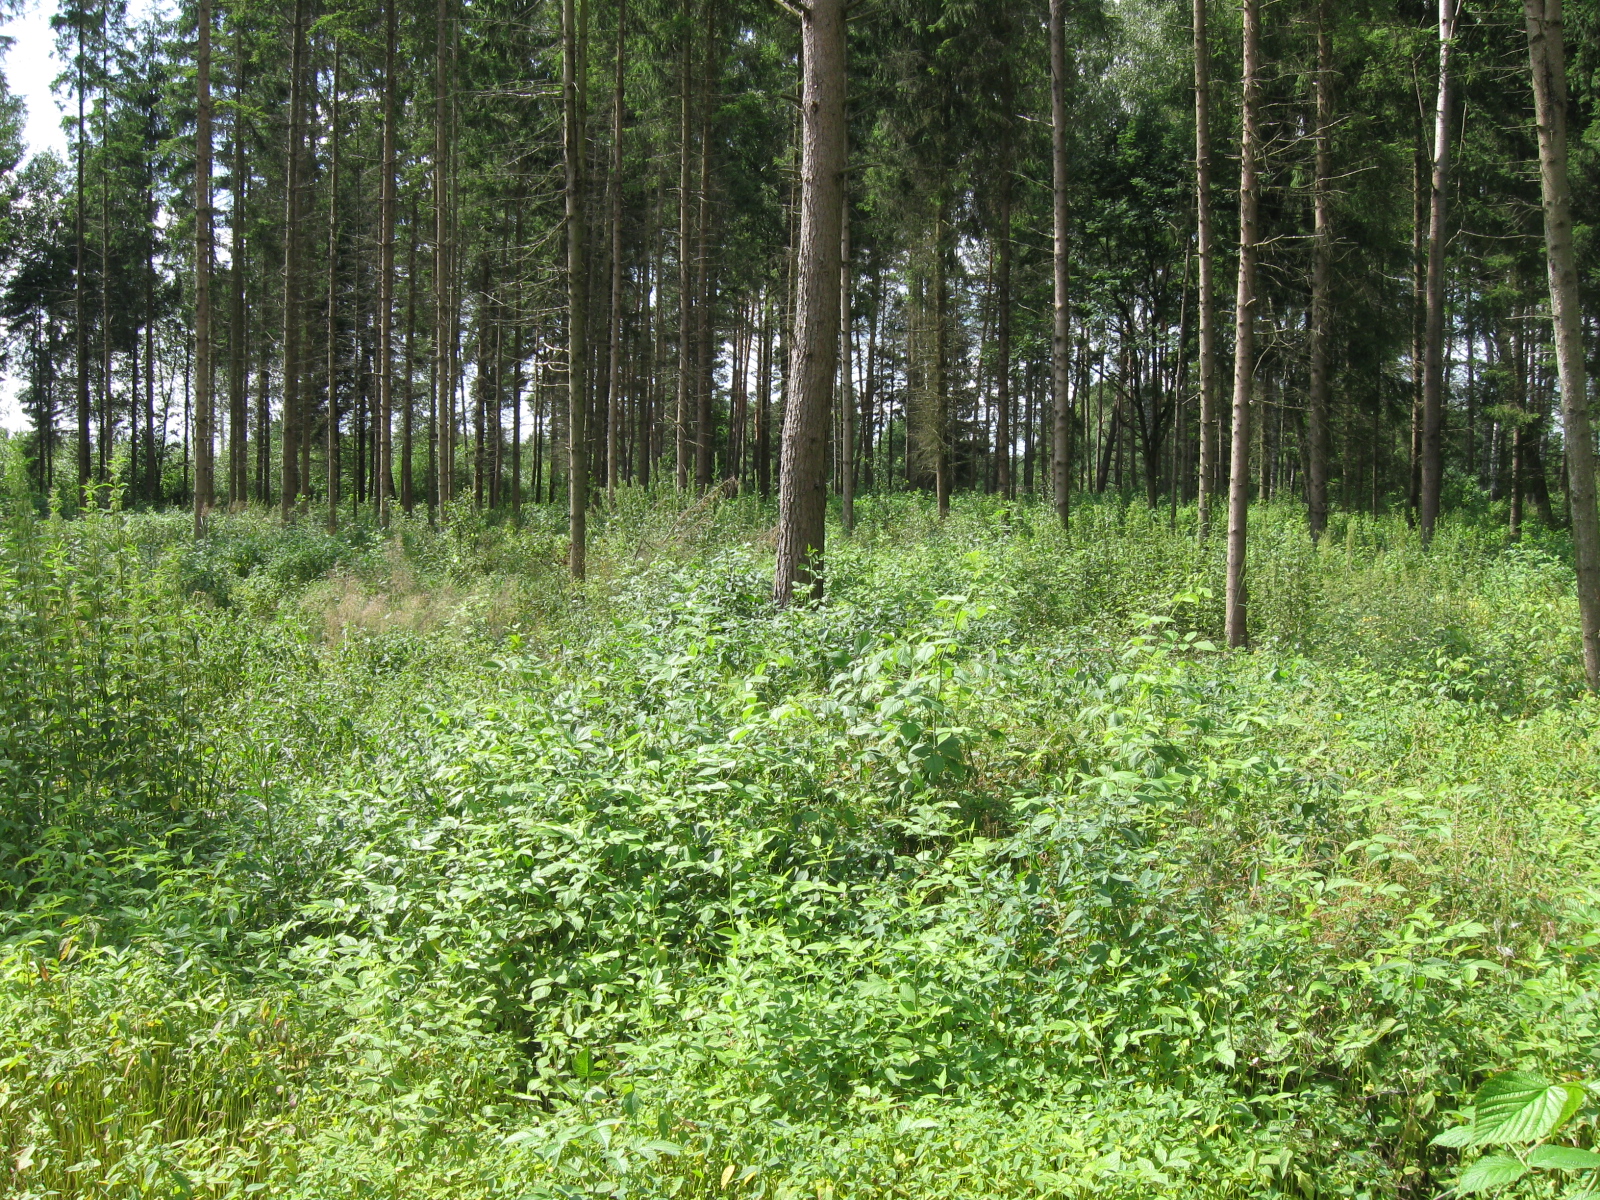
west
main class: Shrubland
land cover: Shrubland with sparse tree cover
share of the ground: 50 - 75 %
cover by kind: herbaceous plants 50 %, shrubs 45 %, coniferous forest trees 5 %
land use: Forestry
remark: Clear cut
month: July
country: LT
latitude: 55.1277
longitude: 23.4569
